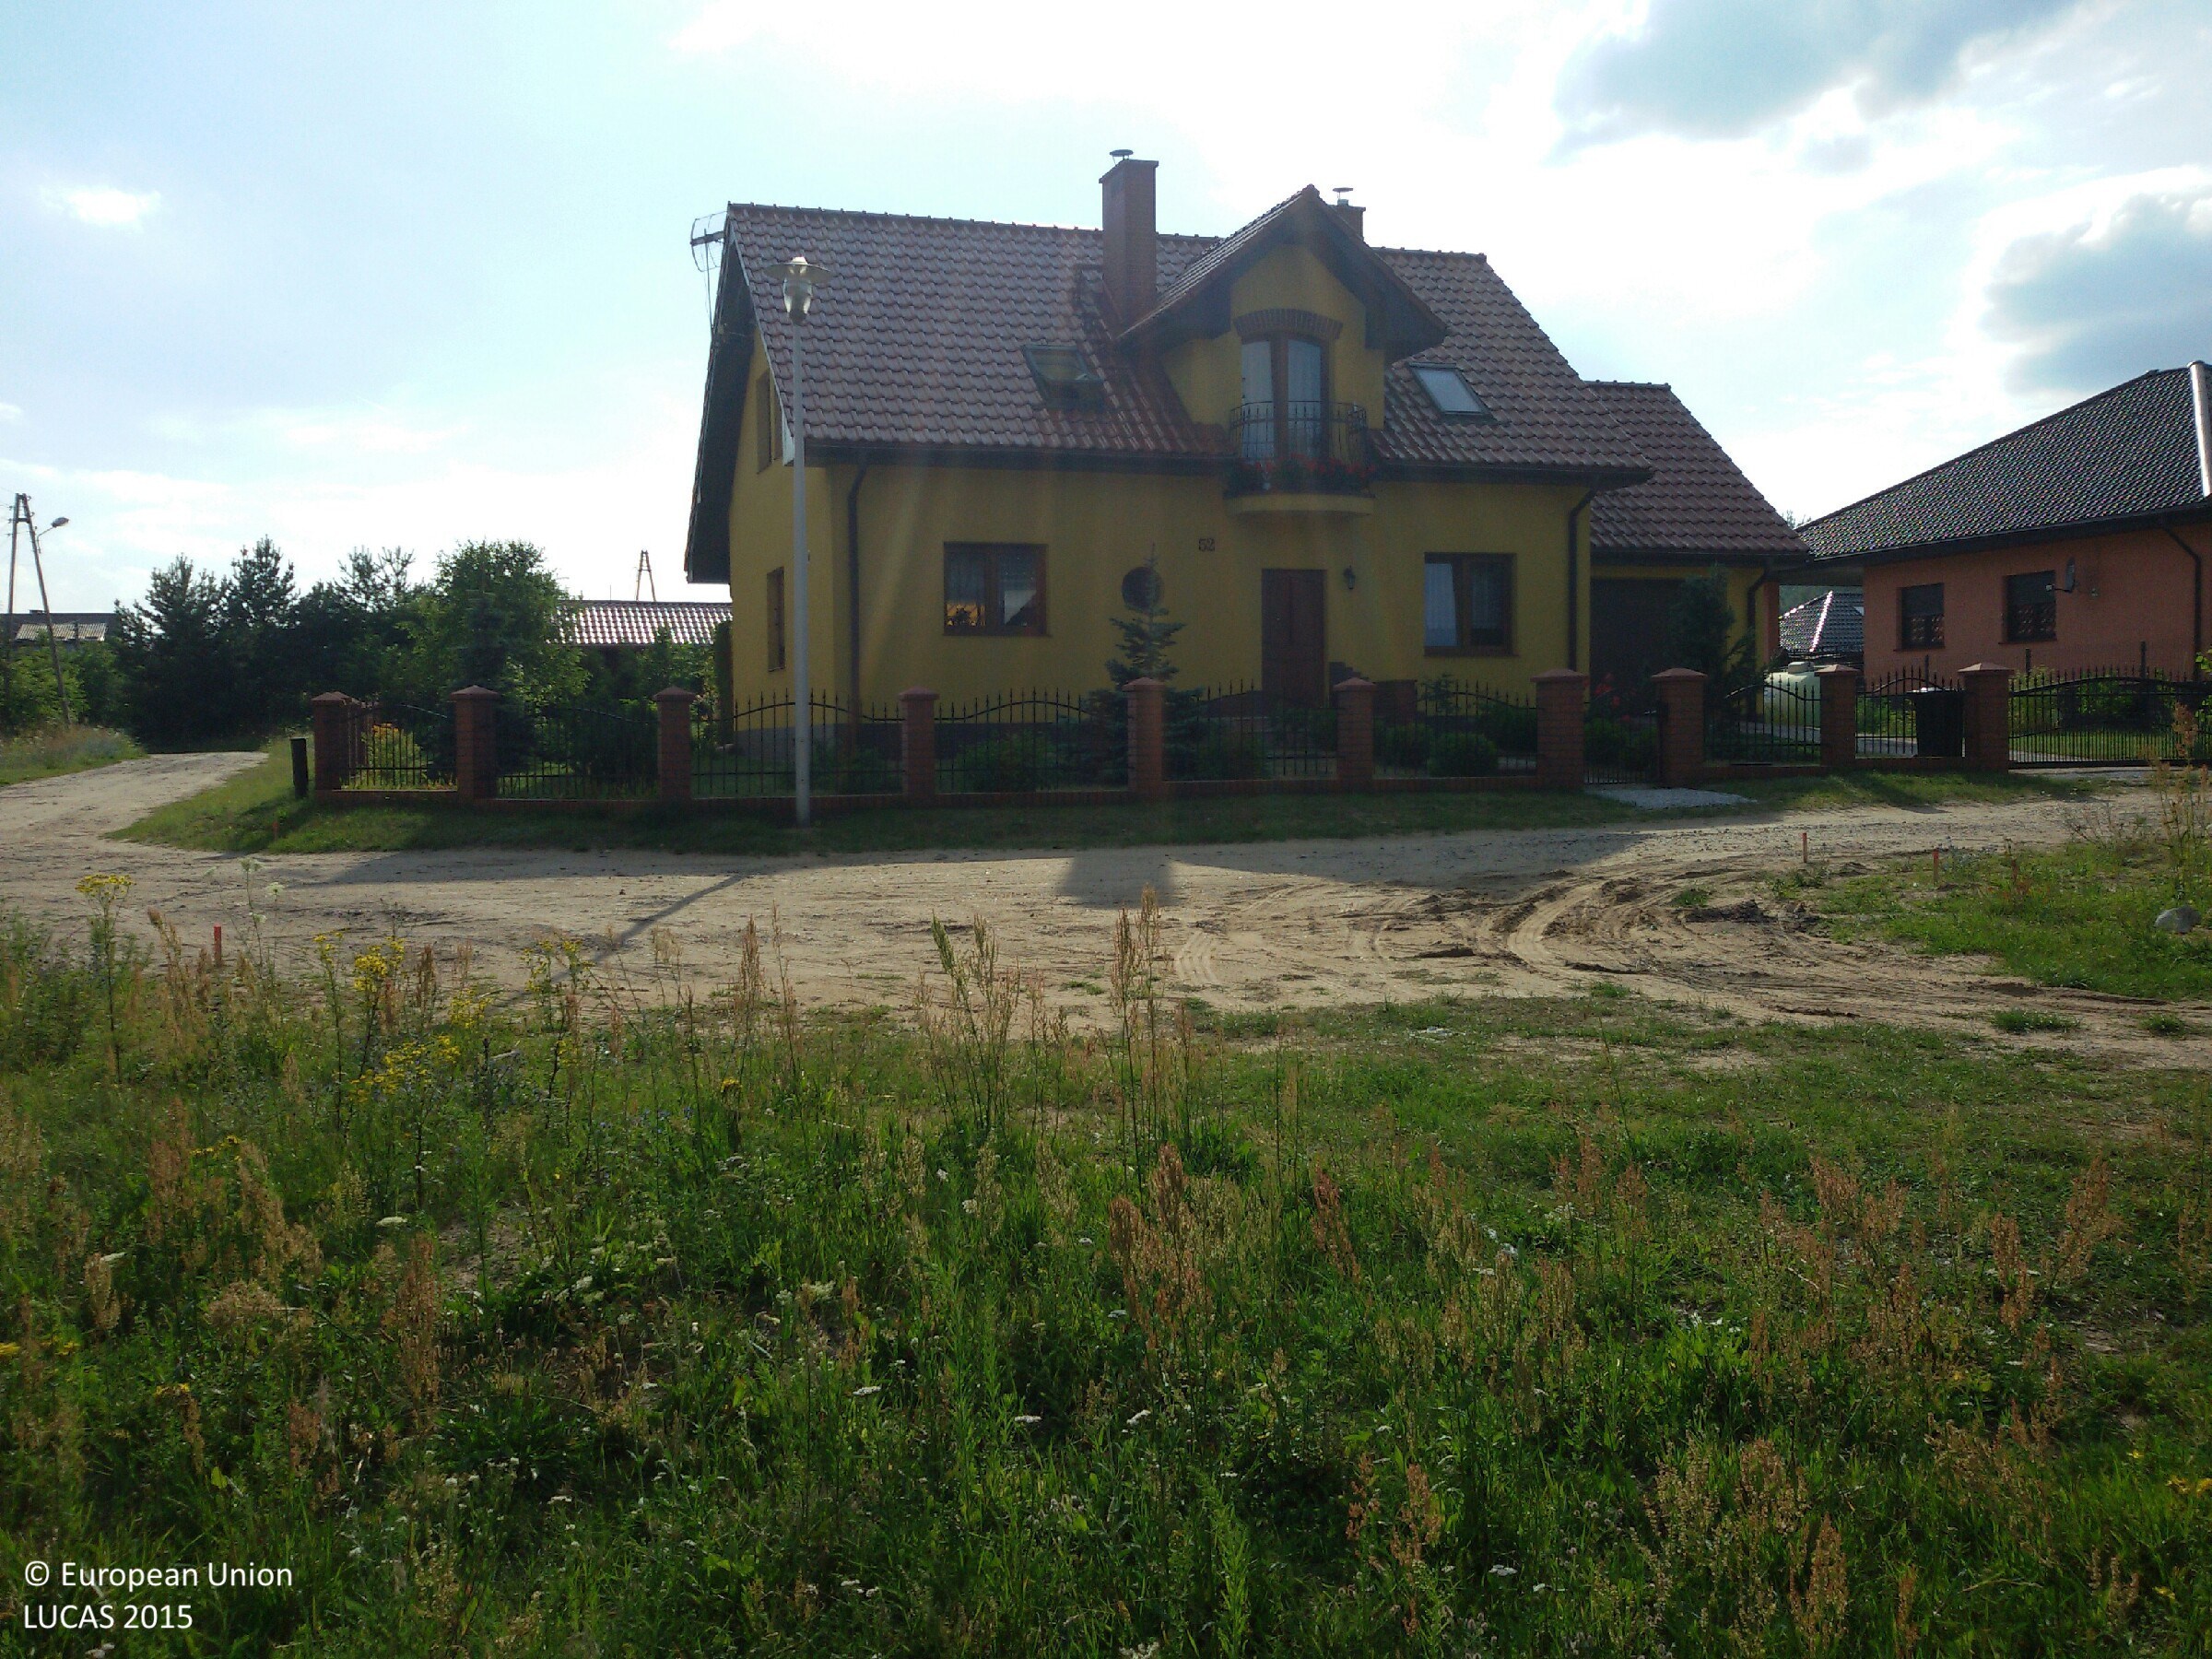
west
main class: Grassland
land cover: Spontaneously vegetated surfaces
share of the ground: > 75 %
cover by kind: herbaceous plants 100 %
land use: Construction
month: July
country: PL
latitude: 53.2118
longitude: 15.7393
